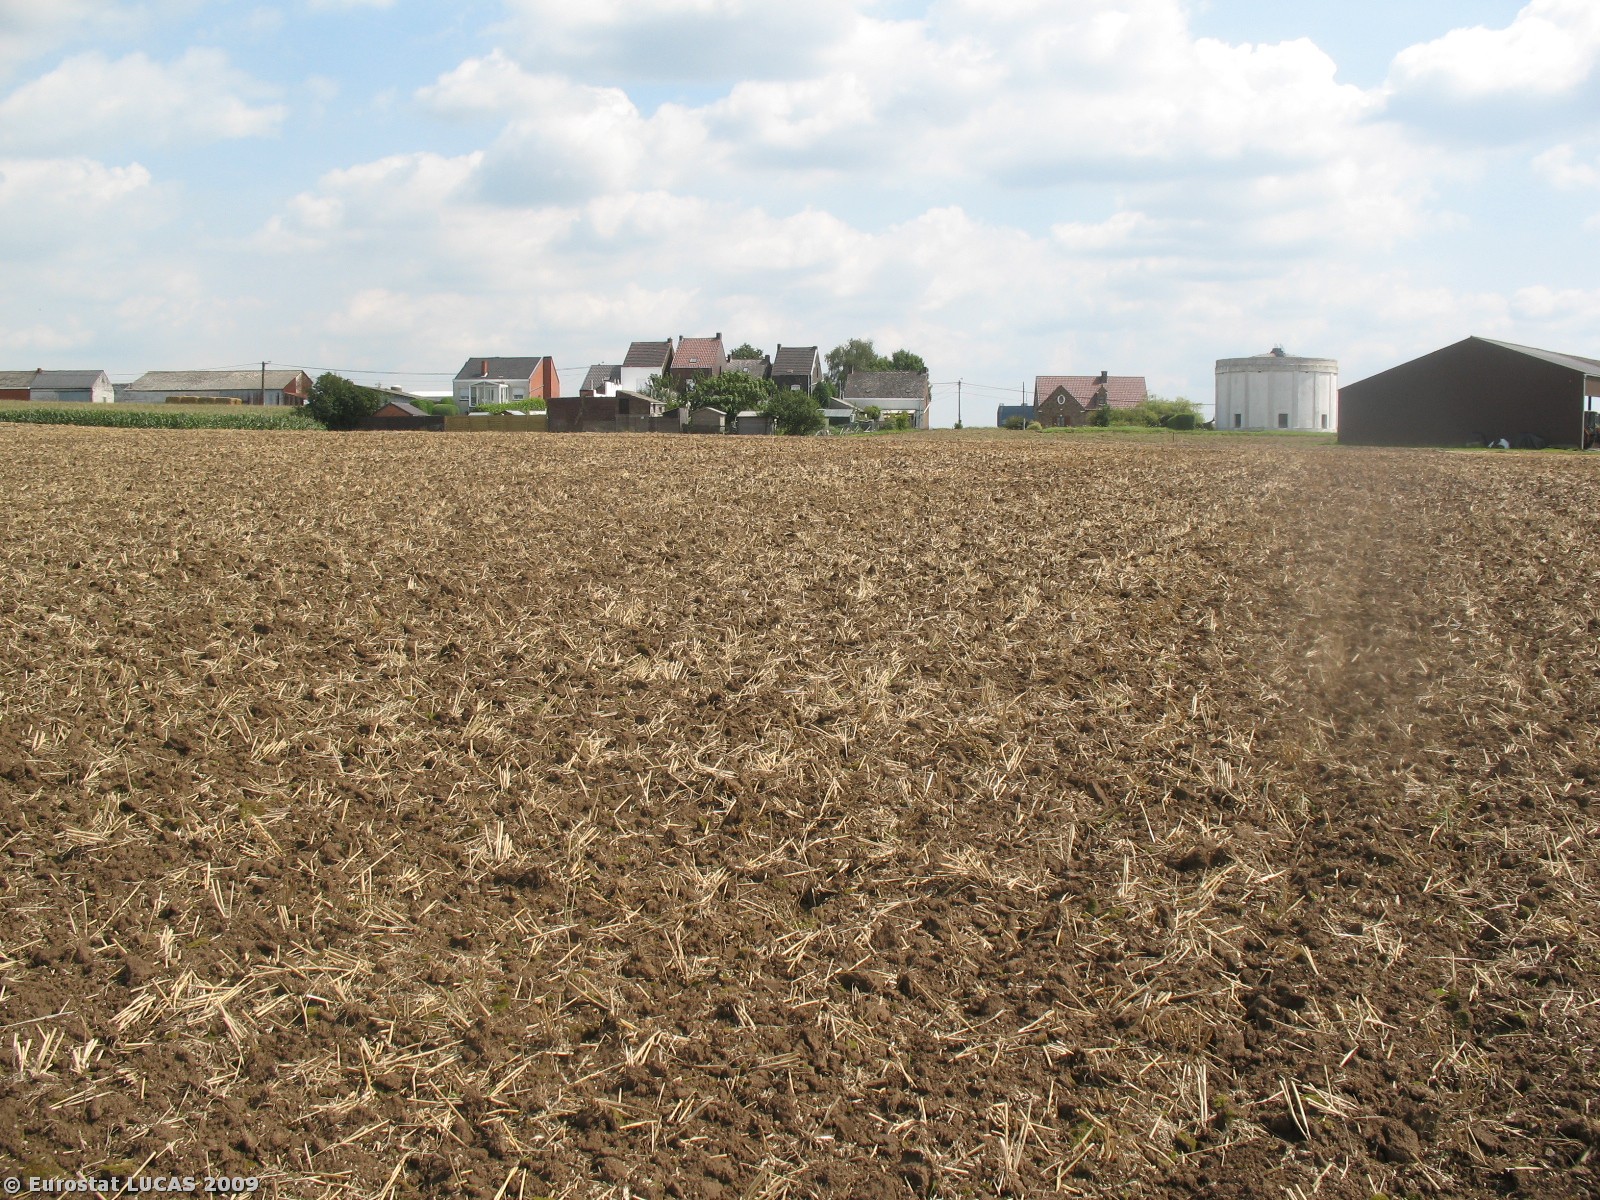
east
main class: Cropland
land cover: Common wheat
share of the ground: > 75 %
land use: Agriculture (excluding fallow land and kitchen gardens)
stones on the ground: < 10 %
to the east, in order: Common wheat; Artificial constructions in urban areas; Paved roads, cycling and walking lanes; Grass margins; Electric lines; Fences; Grassland without tree/shrub cover
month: August
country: BE
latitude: 50.4817
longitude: 4.0896
